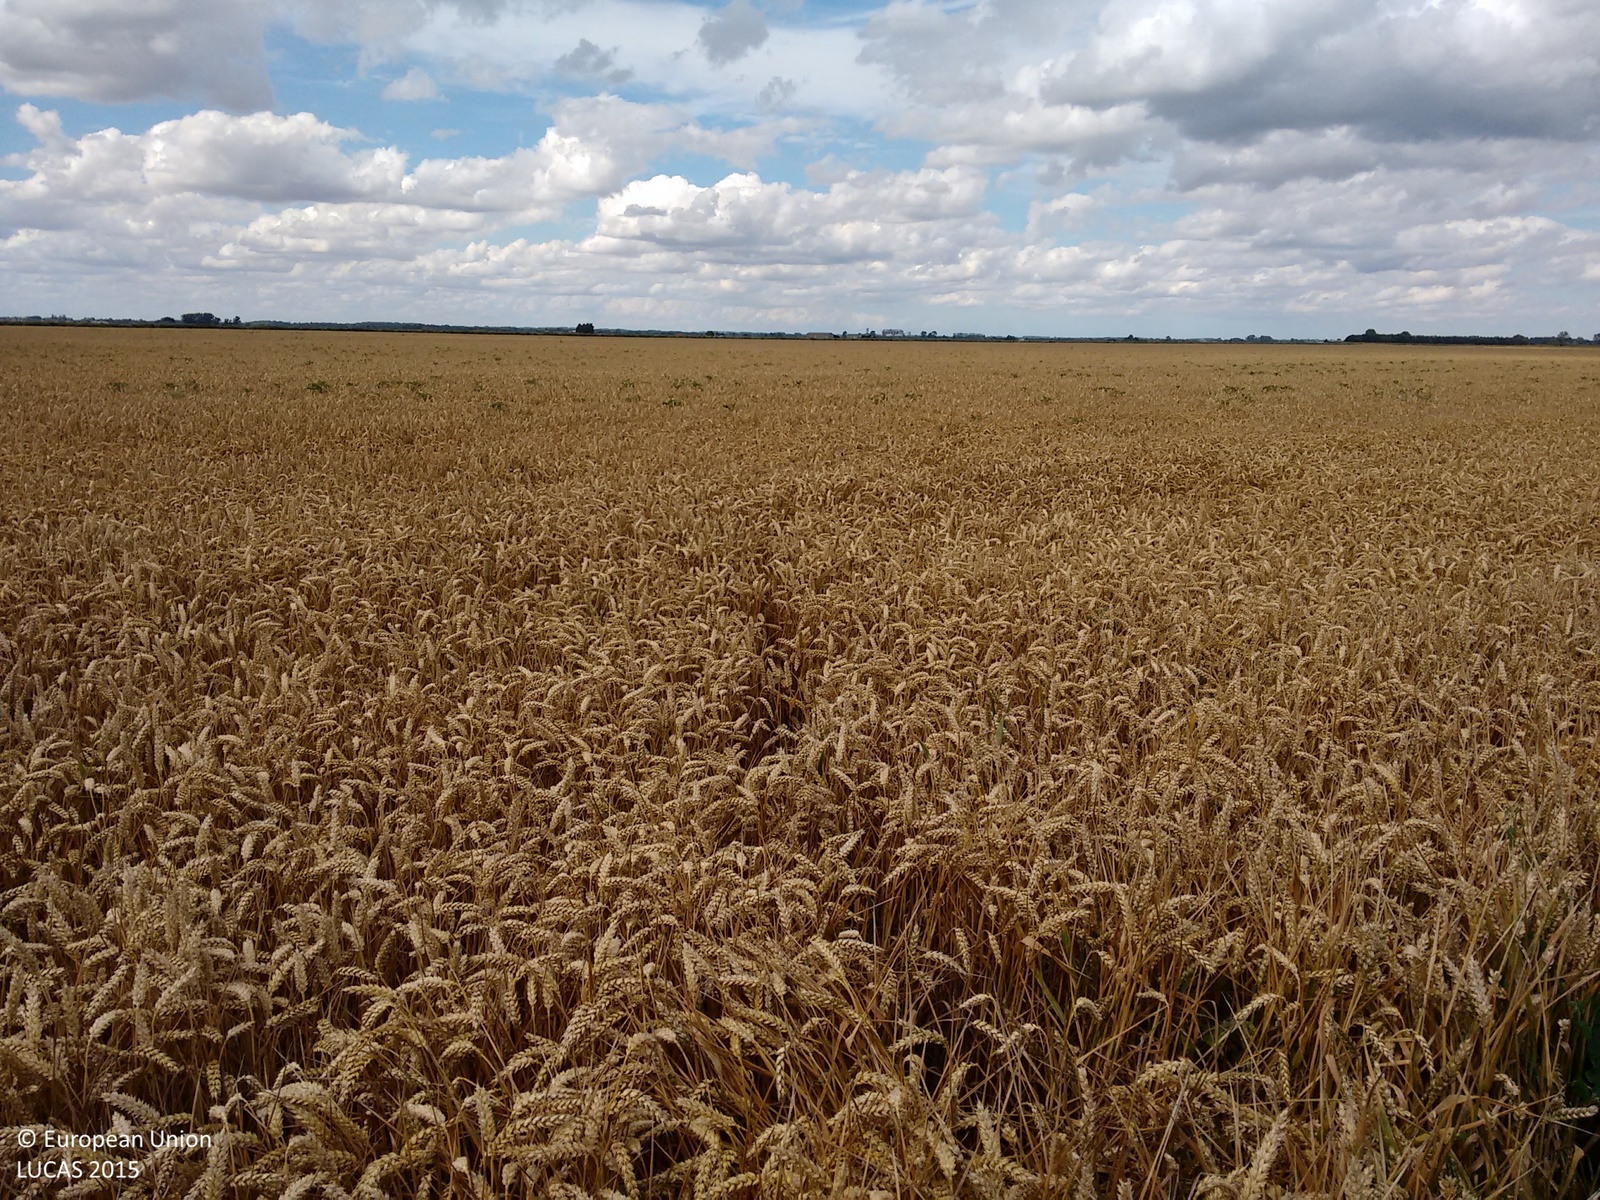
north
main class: Cropland
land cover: Common wheat
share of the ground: > 75 %
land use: Agriculture (excluding fallow land and kitchen gardens)
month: August
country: GB
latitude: 52.4802
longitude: 0.4454
